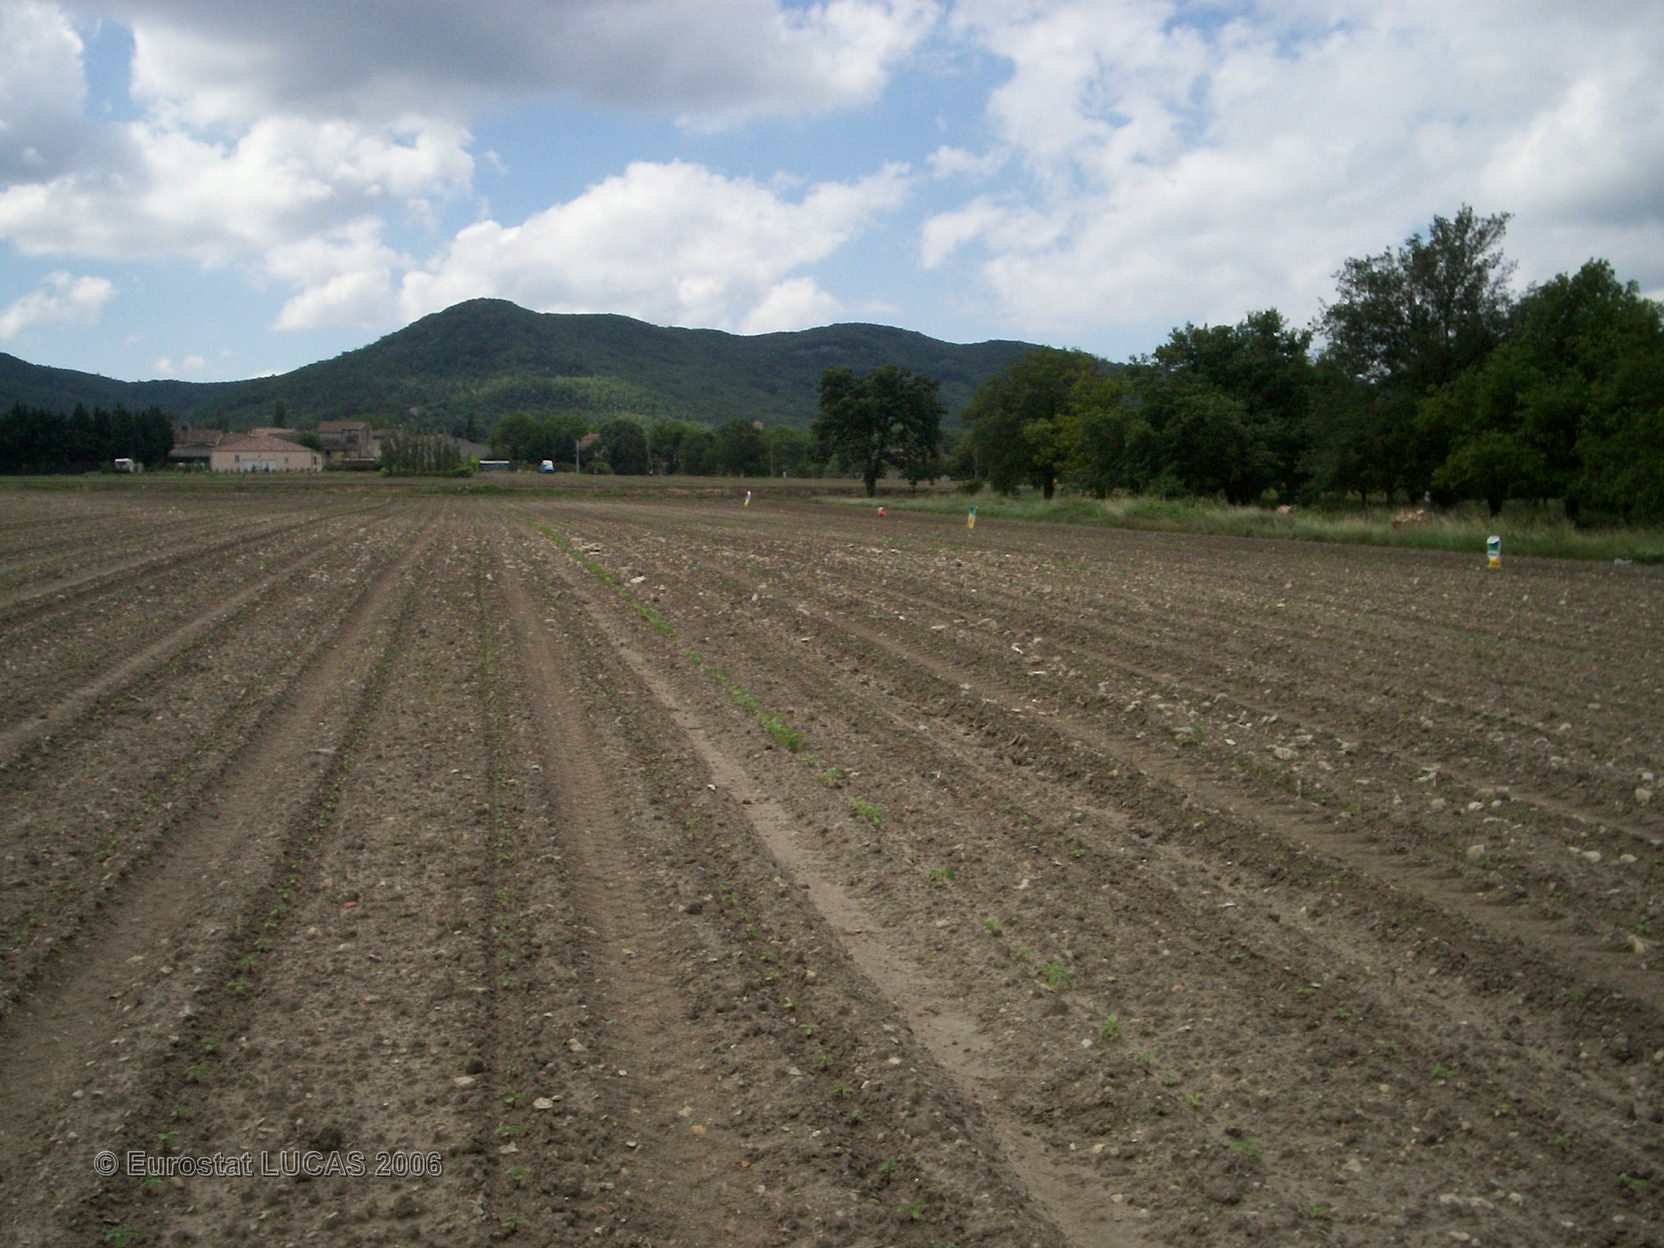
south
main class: Cropland
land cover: Sunflower
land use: Agriculture (excluding fallow land and kitchen gardens)
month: June
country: FR
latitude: 44.5328
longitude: 4.9103
